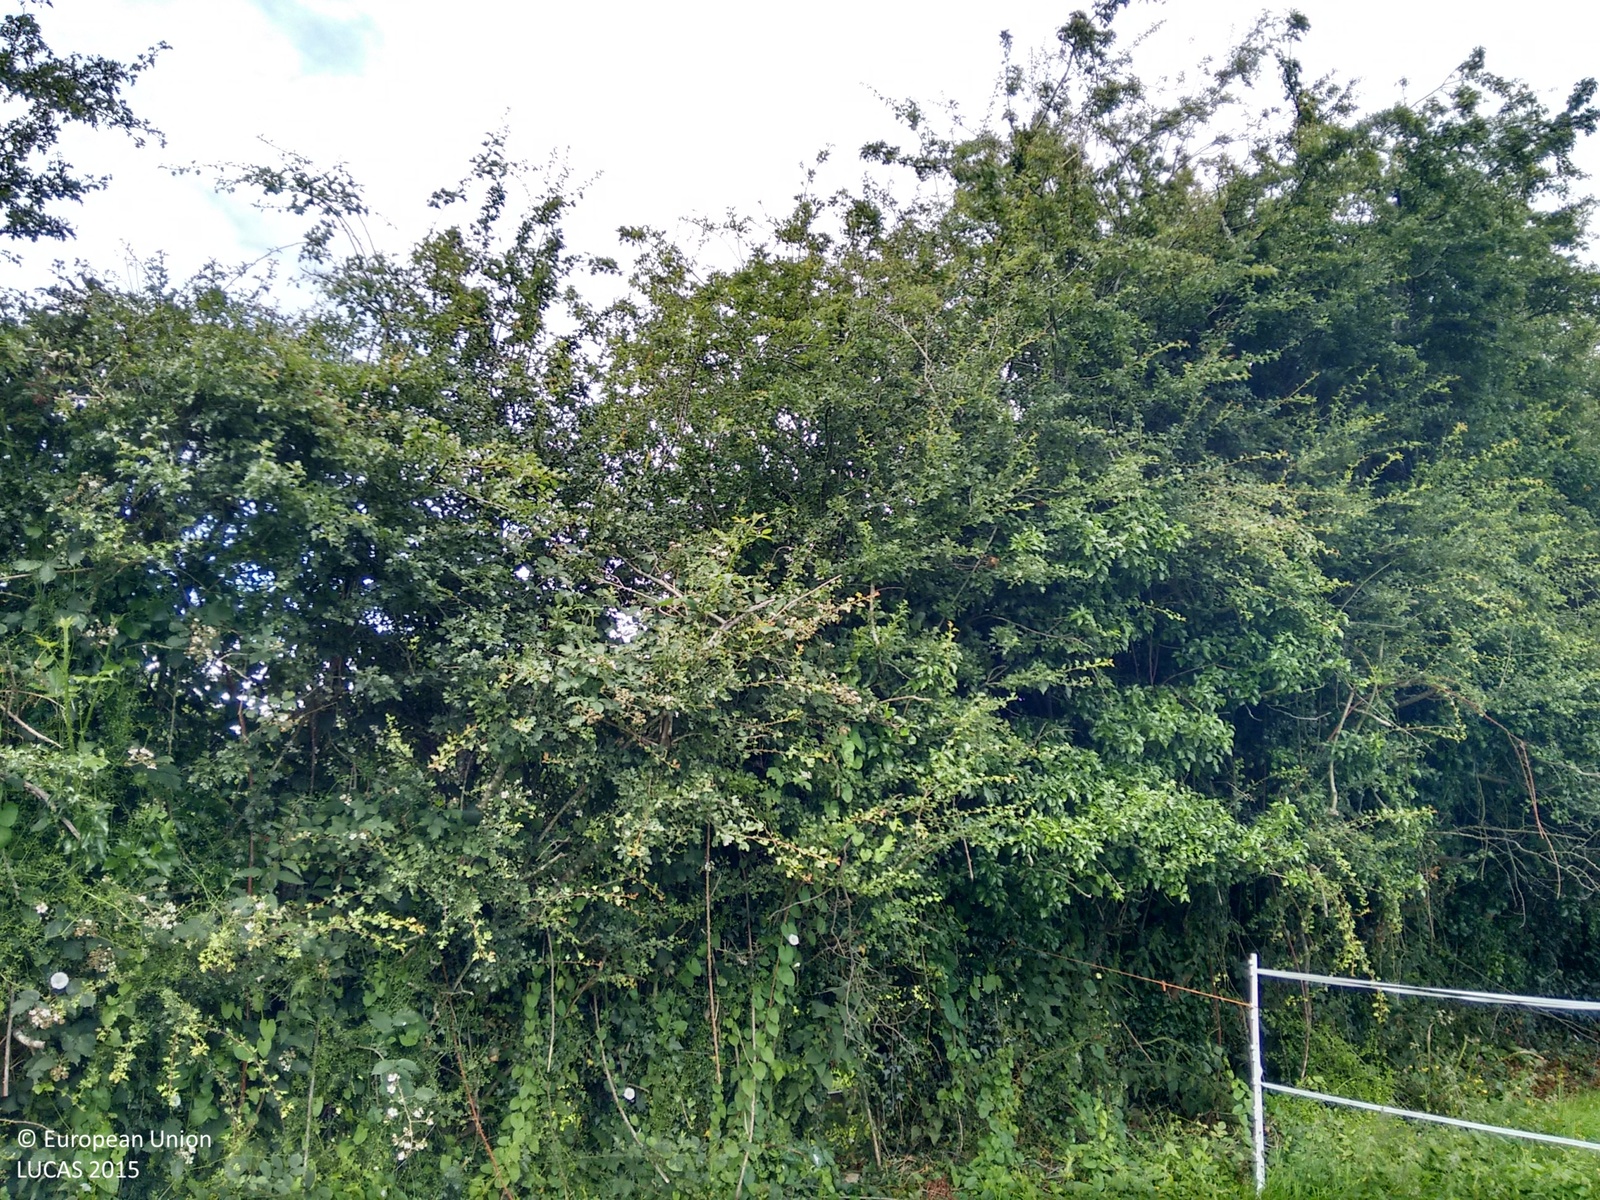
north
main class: Grassland
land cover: Grassland without tree/shrub cover
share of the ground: > 75 %
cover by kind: herbaceous plants 100 %
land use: Residential
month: July
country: IE
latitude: 52.7976
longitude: -6.4554
